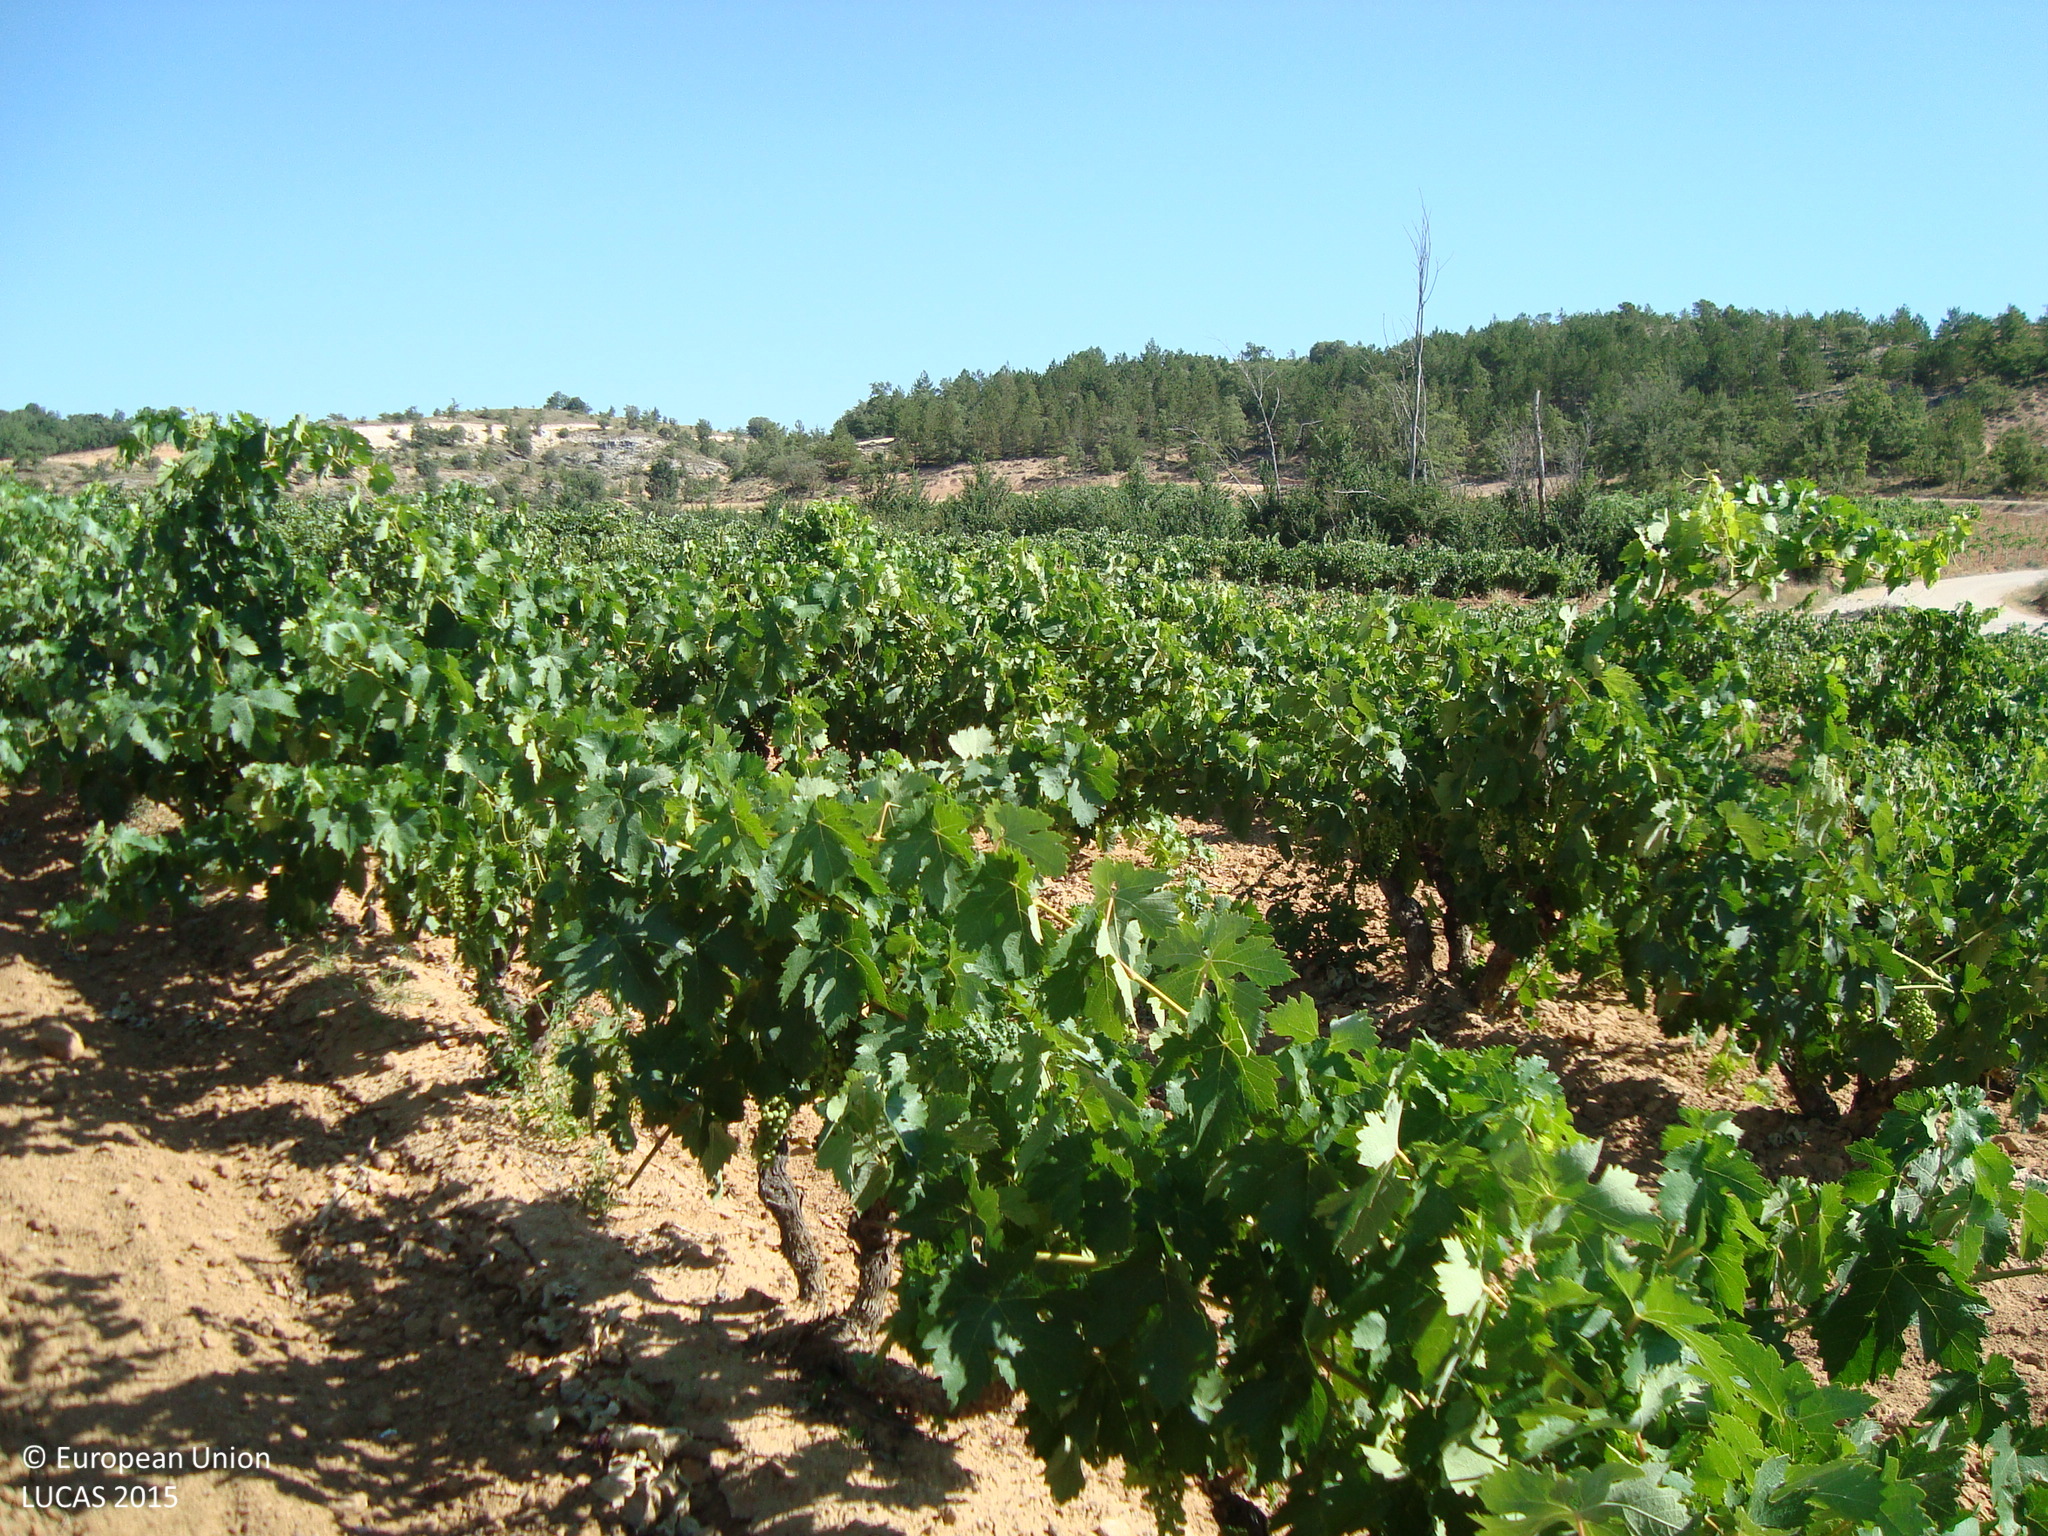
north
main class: Cropland
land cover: Vineyards
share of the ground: 25 - 50 %
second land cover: Other bare soil
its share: > 75 %
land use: Agriculture (excluding fallow land and kitchen gardens)
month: July
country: ES
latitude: 41.7654
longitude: -3.7555
